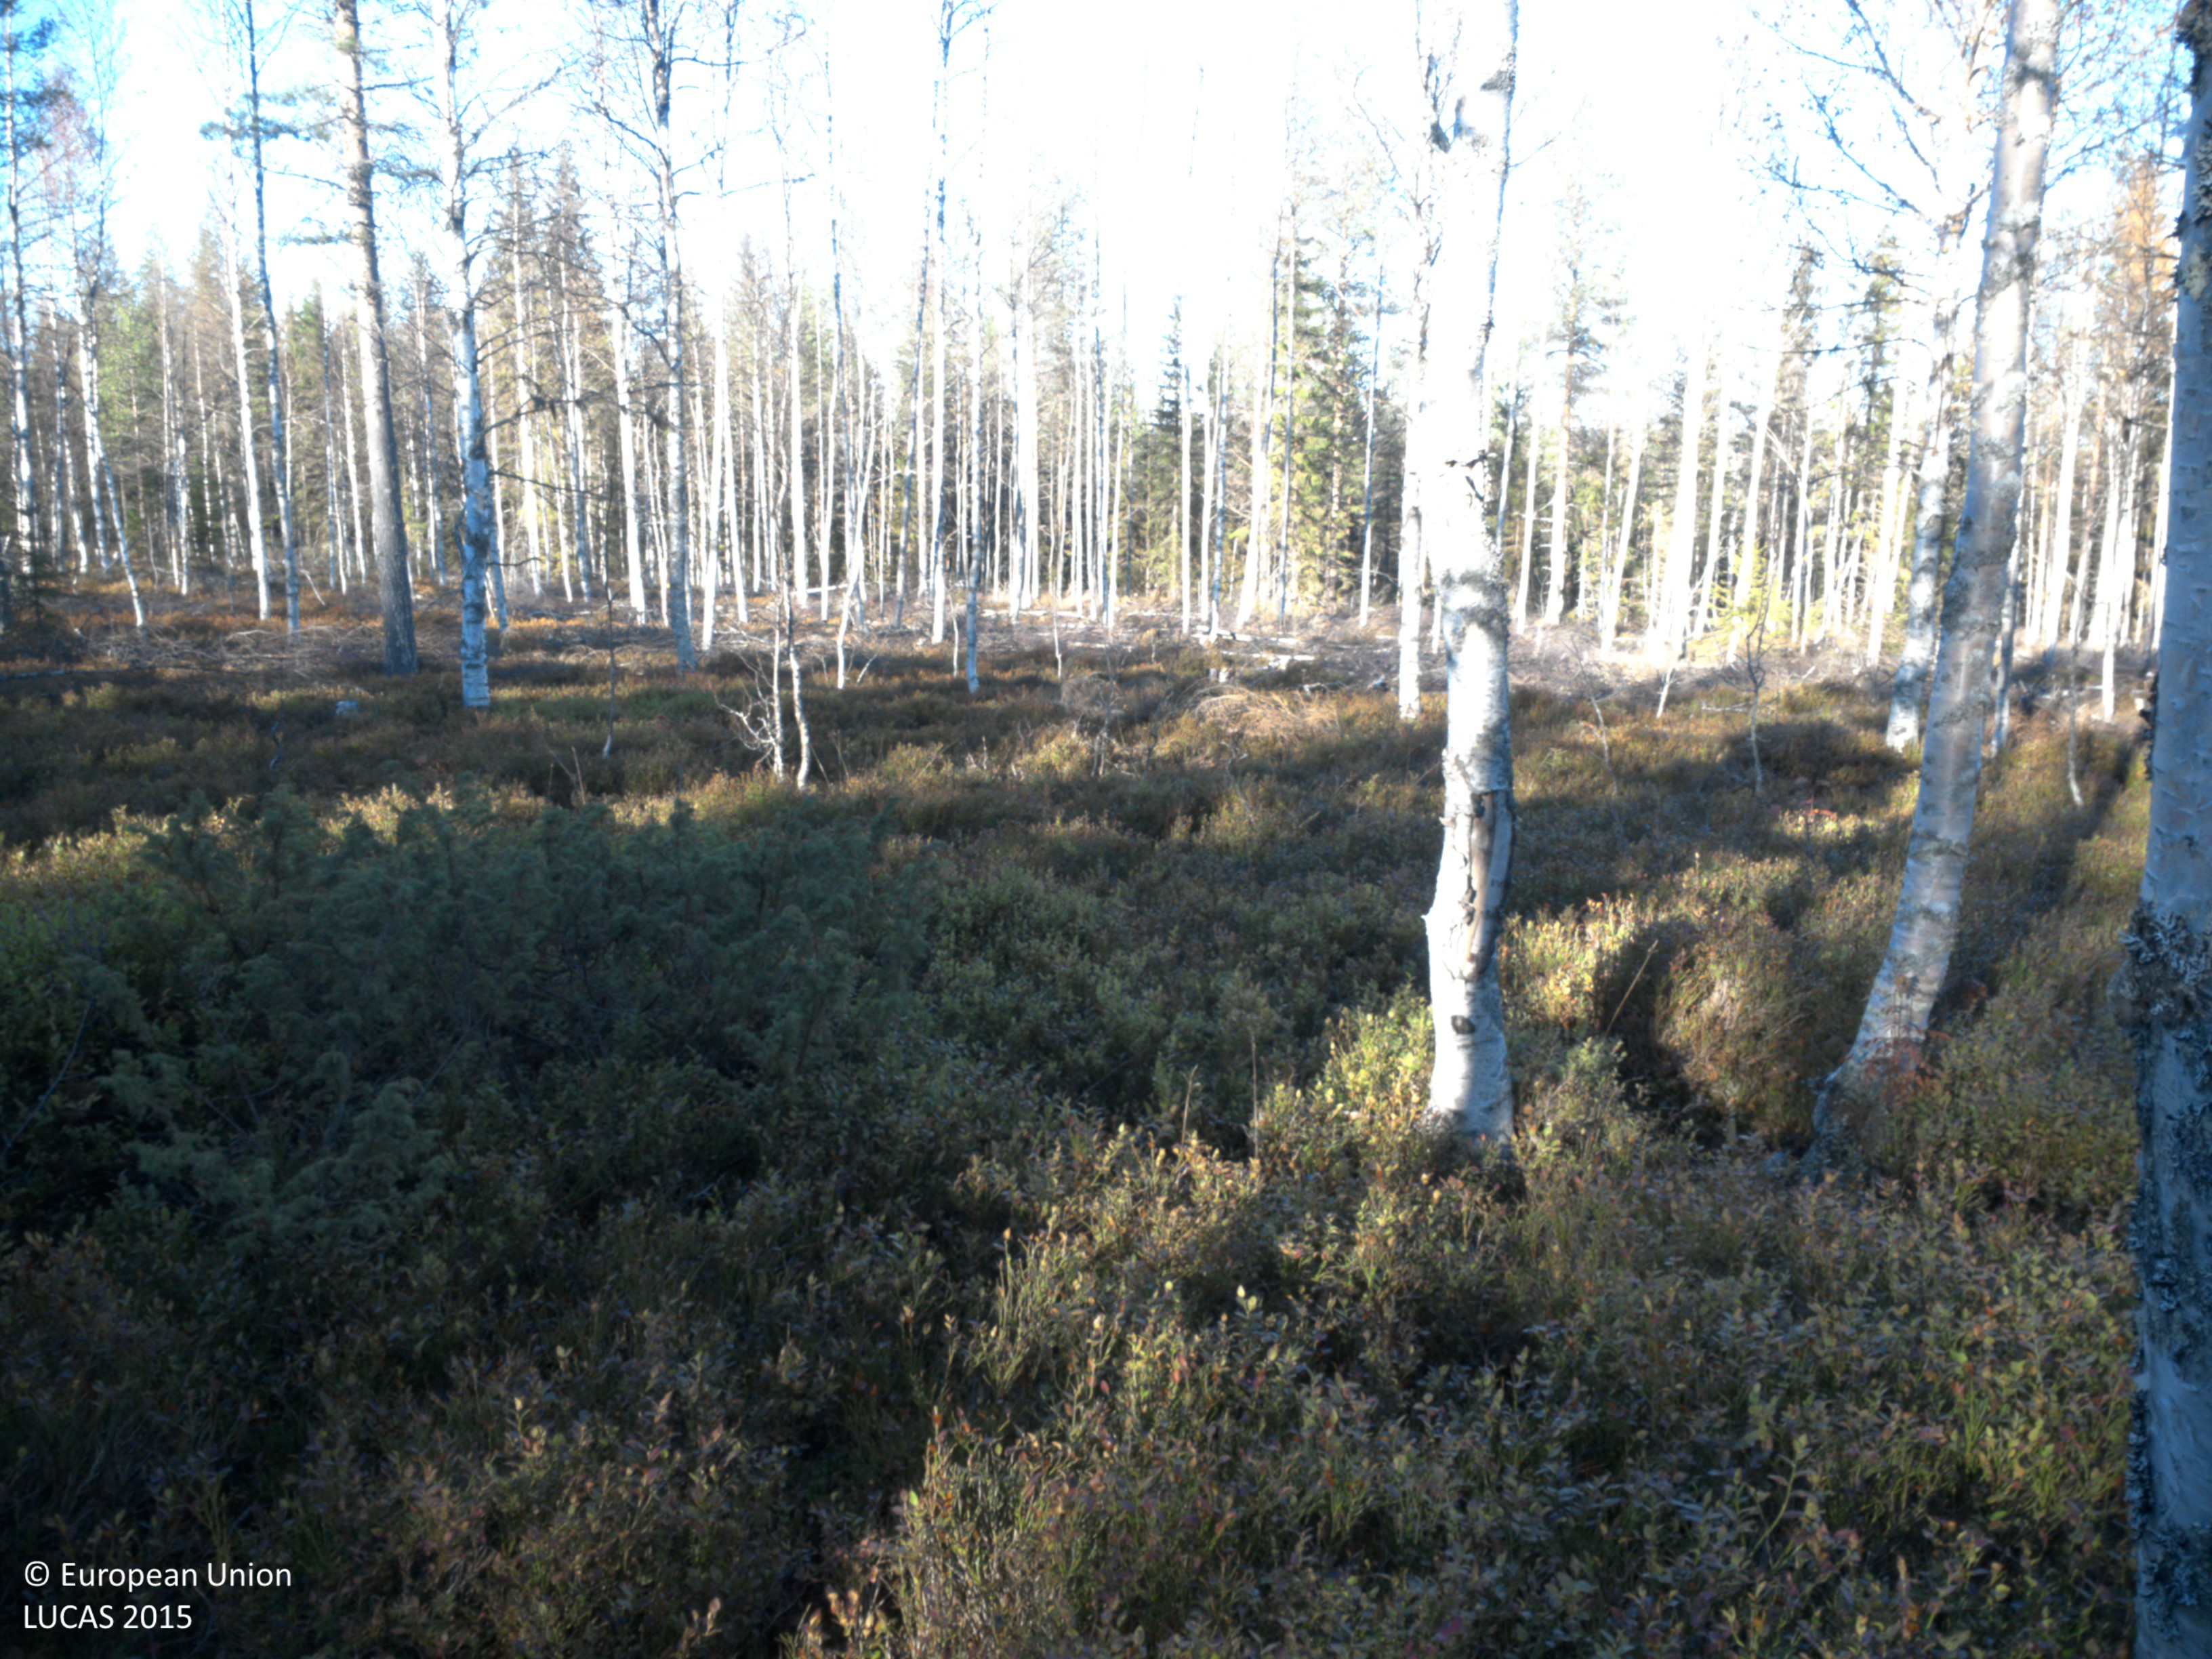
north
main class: Woodland
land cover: Spruce dominated mixed woodland
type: boreal forest
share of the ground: 50 - 75 %
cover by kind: coniferous forest trees 50 %, broadleaved forest trees 25 %, shrubs 15 %, herbaceous plants 5 %, lichens and mosses 5 %
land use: Forestry
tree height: > 5 m
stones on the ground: < 10 %
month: October
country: SE
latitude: 64.0781
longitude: 18.8505
